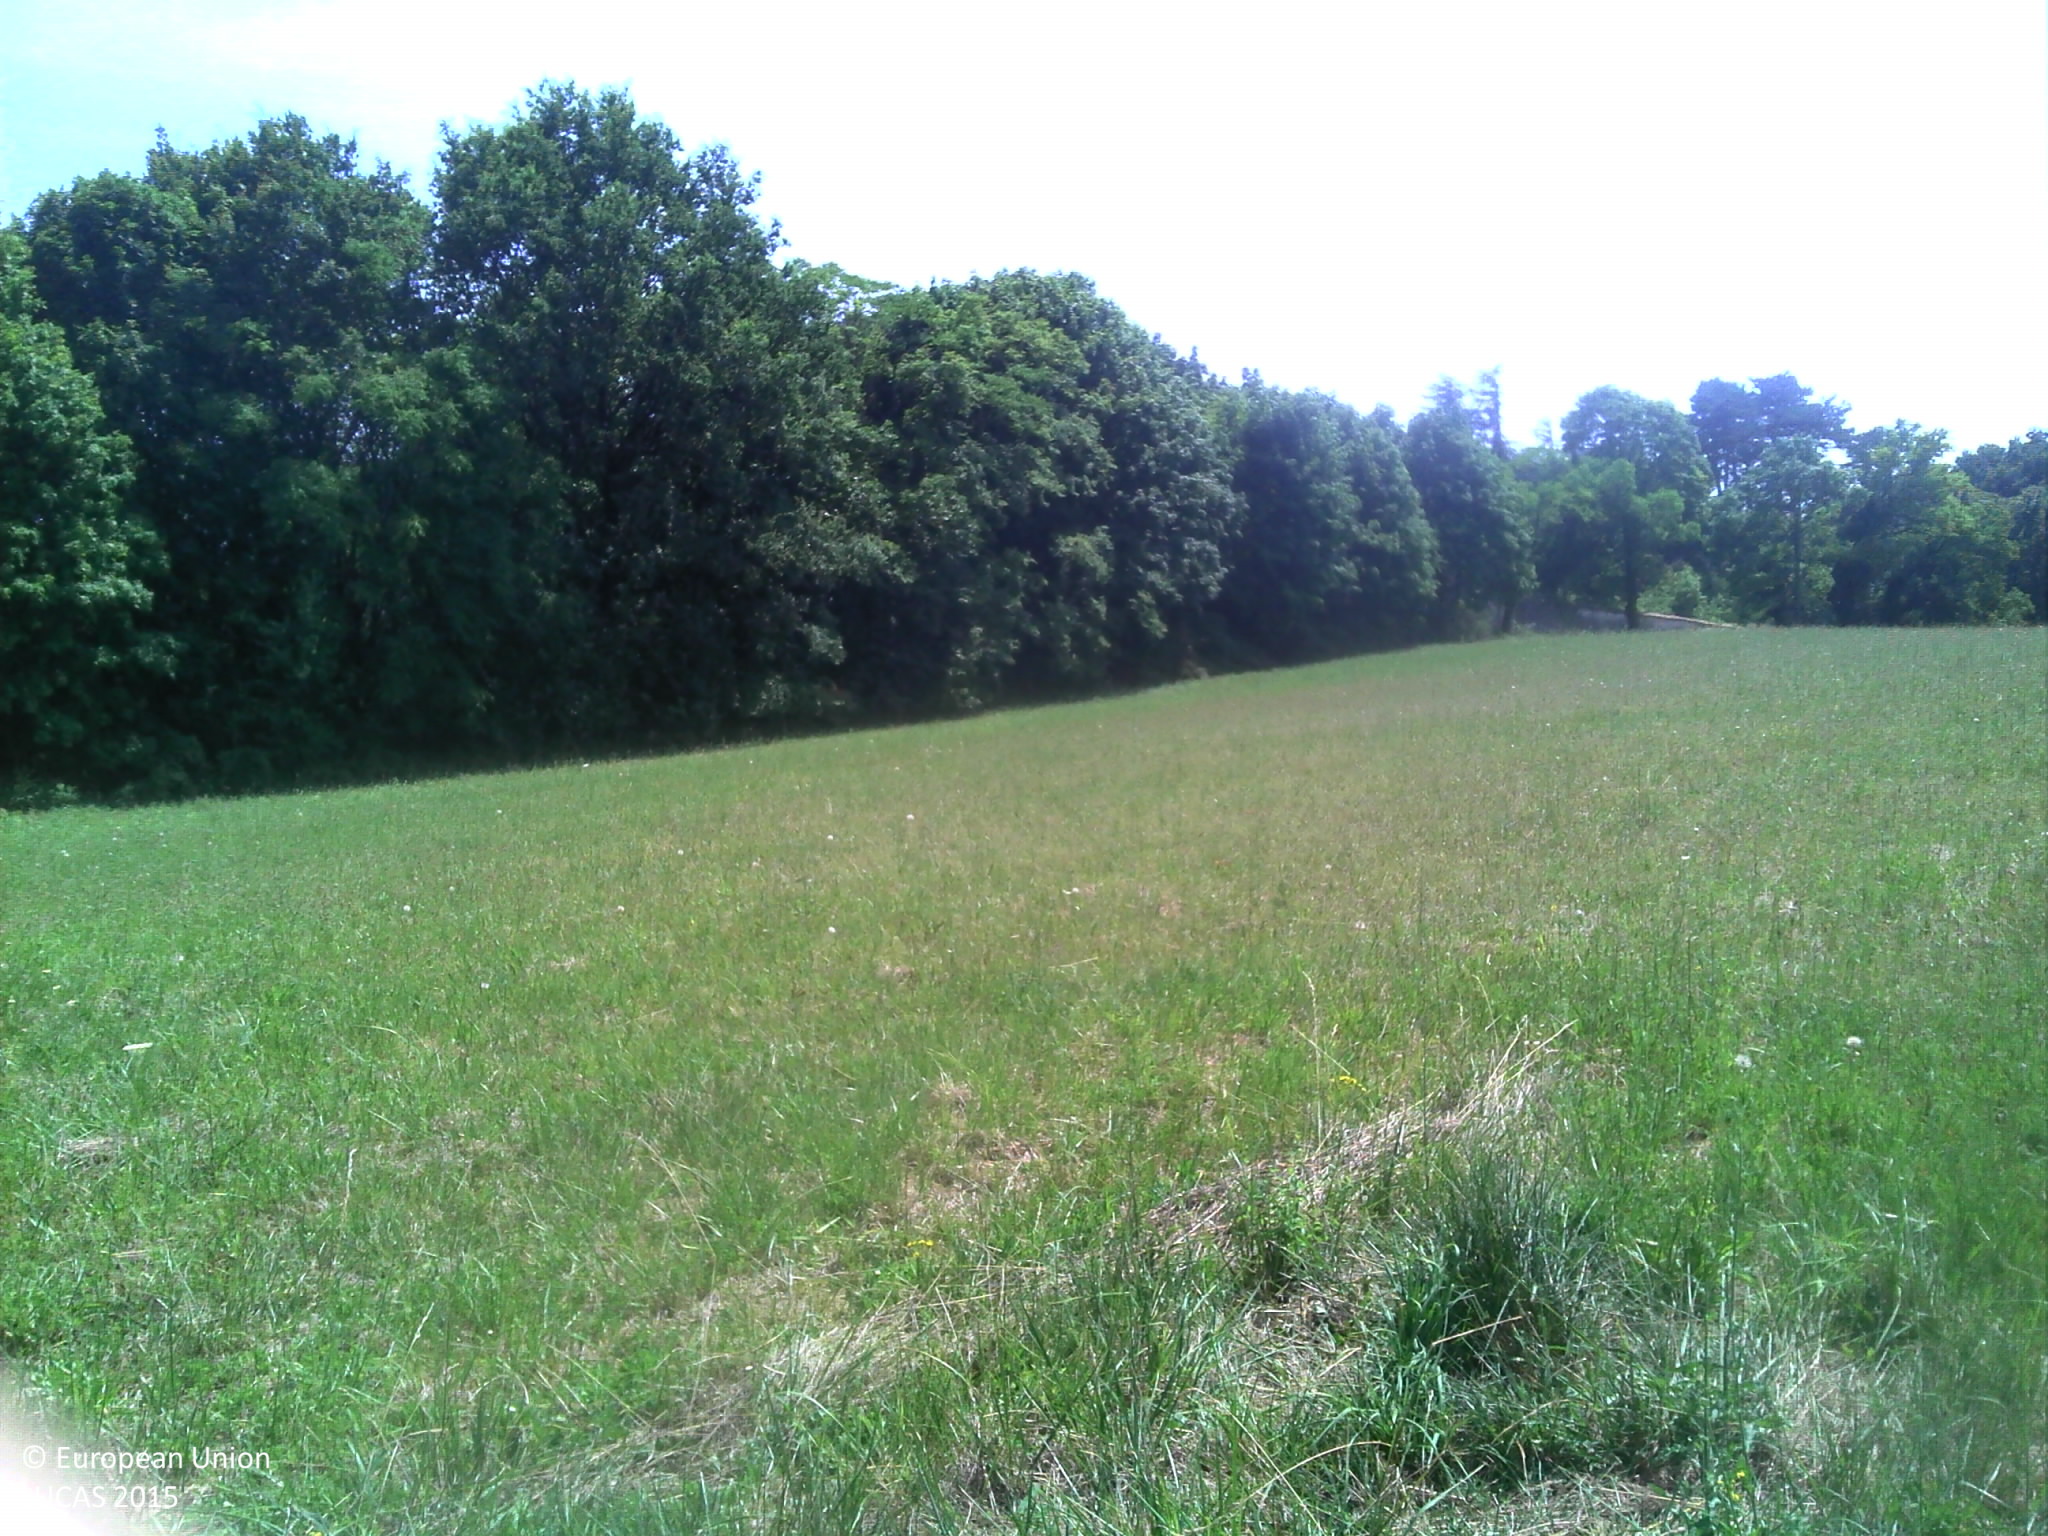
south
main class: Grassland
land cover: Grassland without tree/shrub cover
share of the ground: > 75 %
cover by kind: herbaceous plants 100 %
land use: Agriculture (excluding fallow land and kitchen gardens)
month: July
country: FR
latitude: 45.7543
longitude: 5.1573
